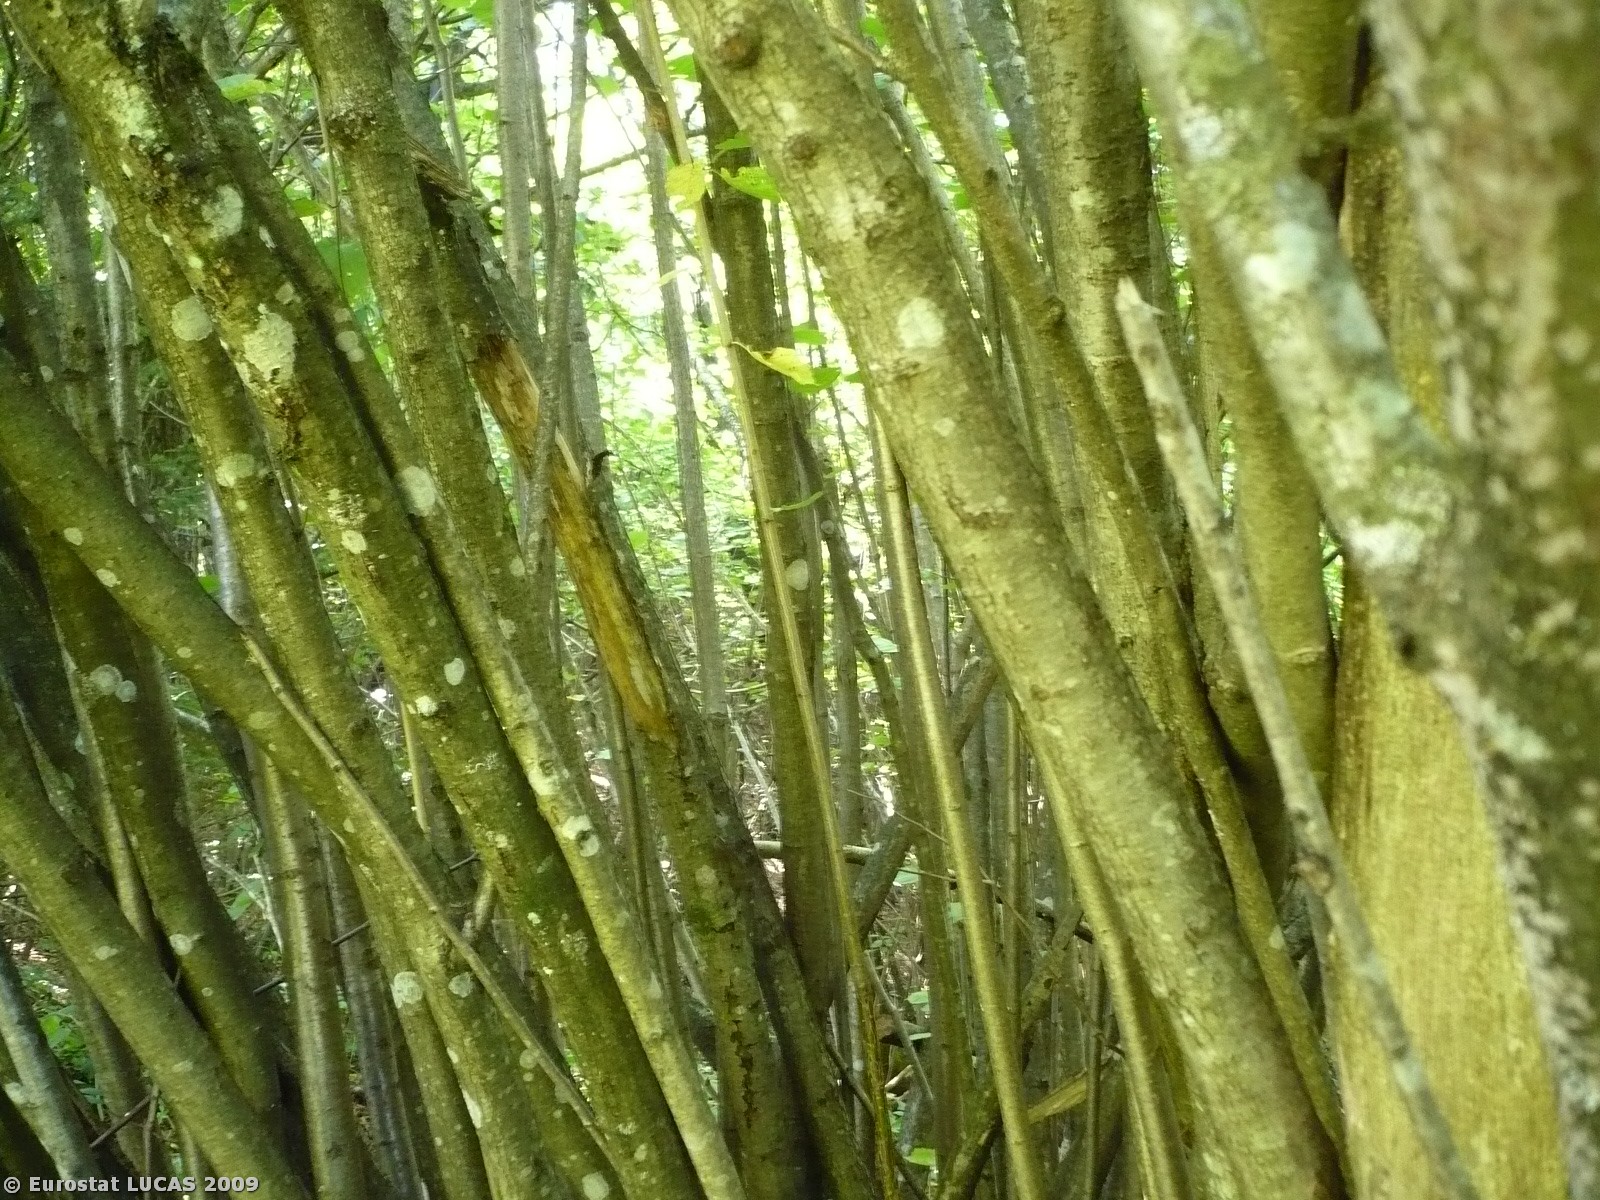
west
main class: Woodland
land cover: Broadleaved woodland
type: mesophytic deciduous forest
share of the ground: > 75 %
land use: Nature reserves
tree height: > 5 m
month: August
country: SI
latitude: 45.9076
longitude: 14.2114
